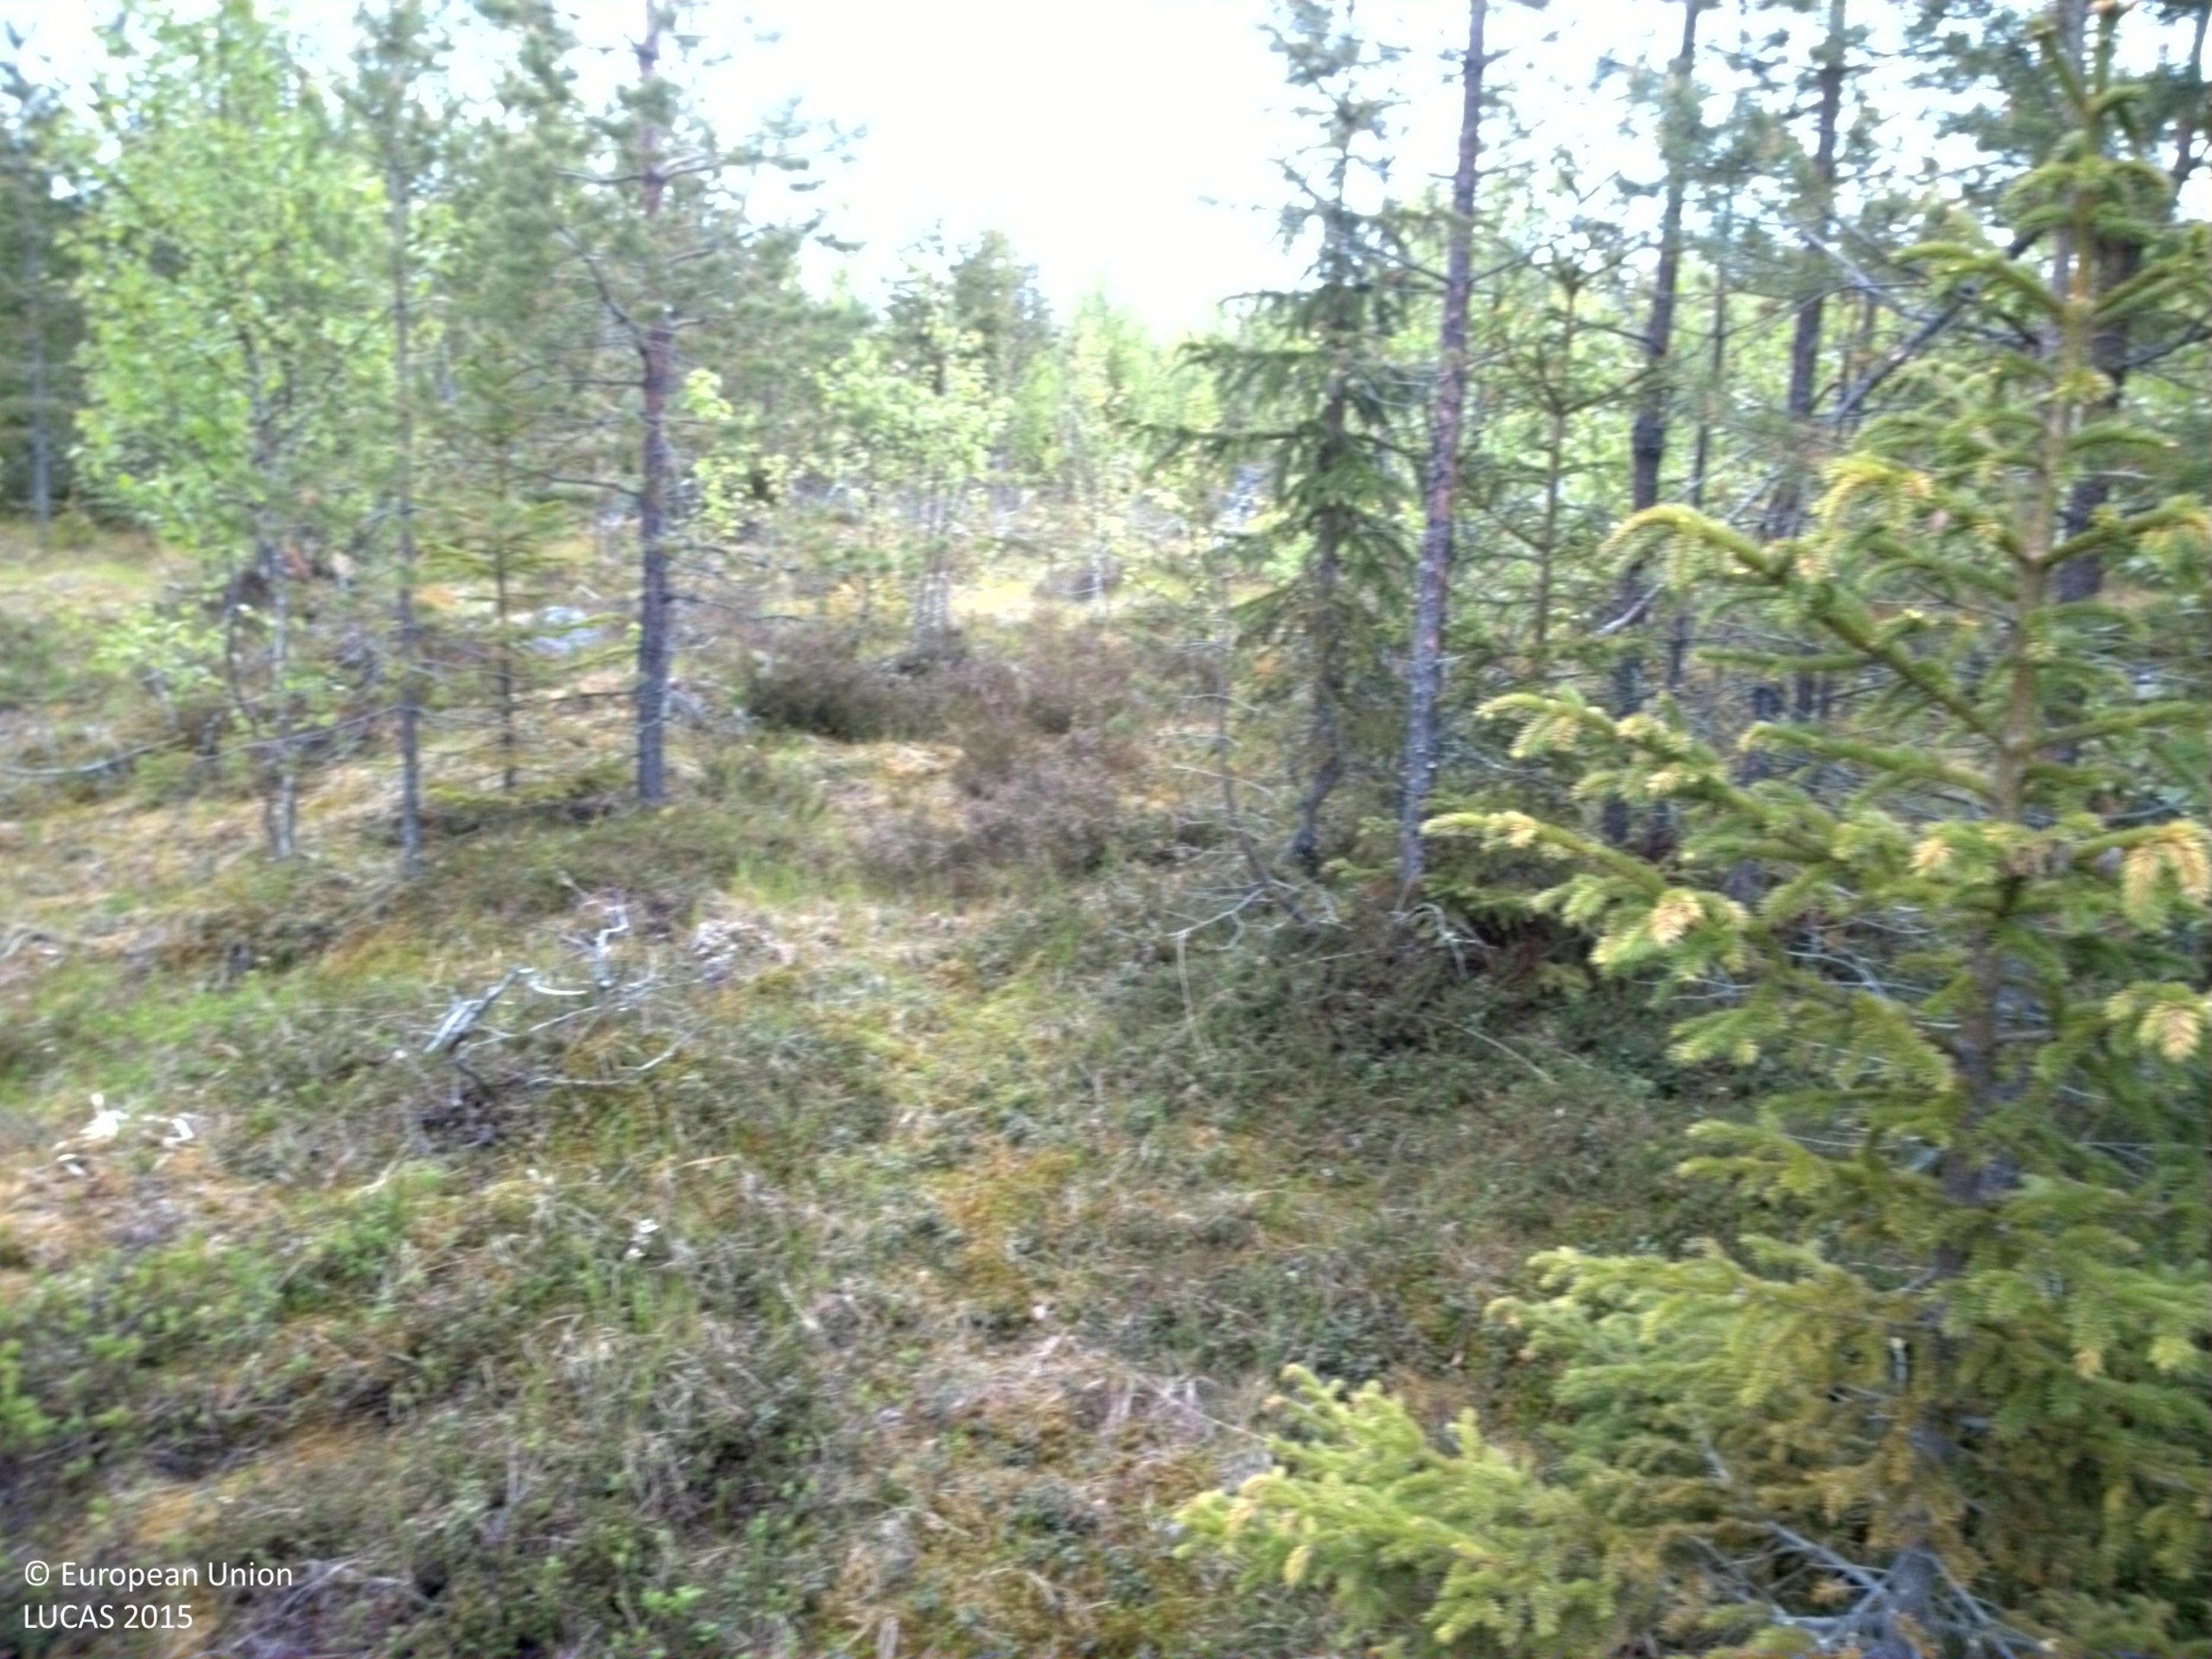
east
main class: Woodland
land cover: Pine dominated mixed woodland
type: boreal forest
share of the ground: 50 - 75 %
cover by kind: coniferous forest trees 45 %, shrubs 40 %, broadleaved forest trees 15 %
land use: Forestry
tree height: < 5 m
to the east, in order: Pine dominated mixed woodland; Shrubland without tree cover; Other mixed woodland; Ditches and canals; Other mixed woodland; Pine dominated mixed woodland
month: June
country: SE
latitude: 63.1626
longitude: 17.9782
